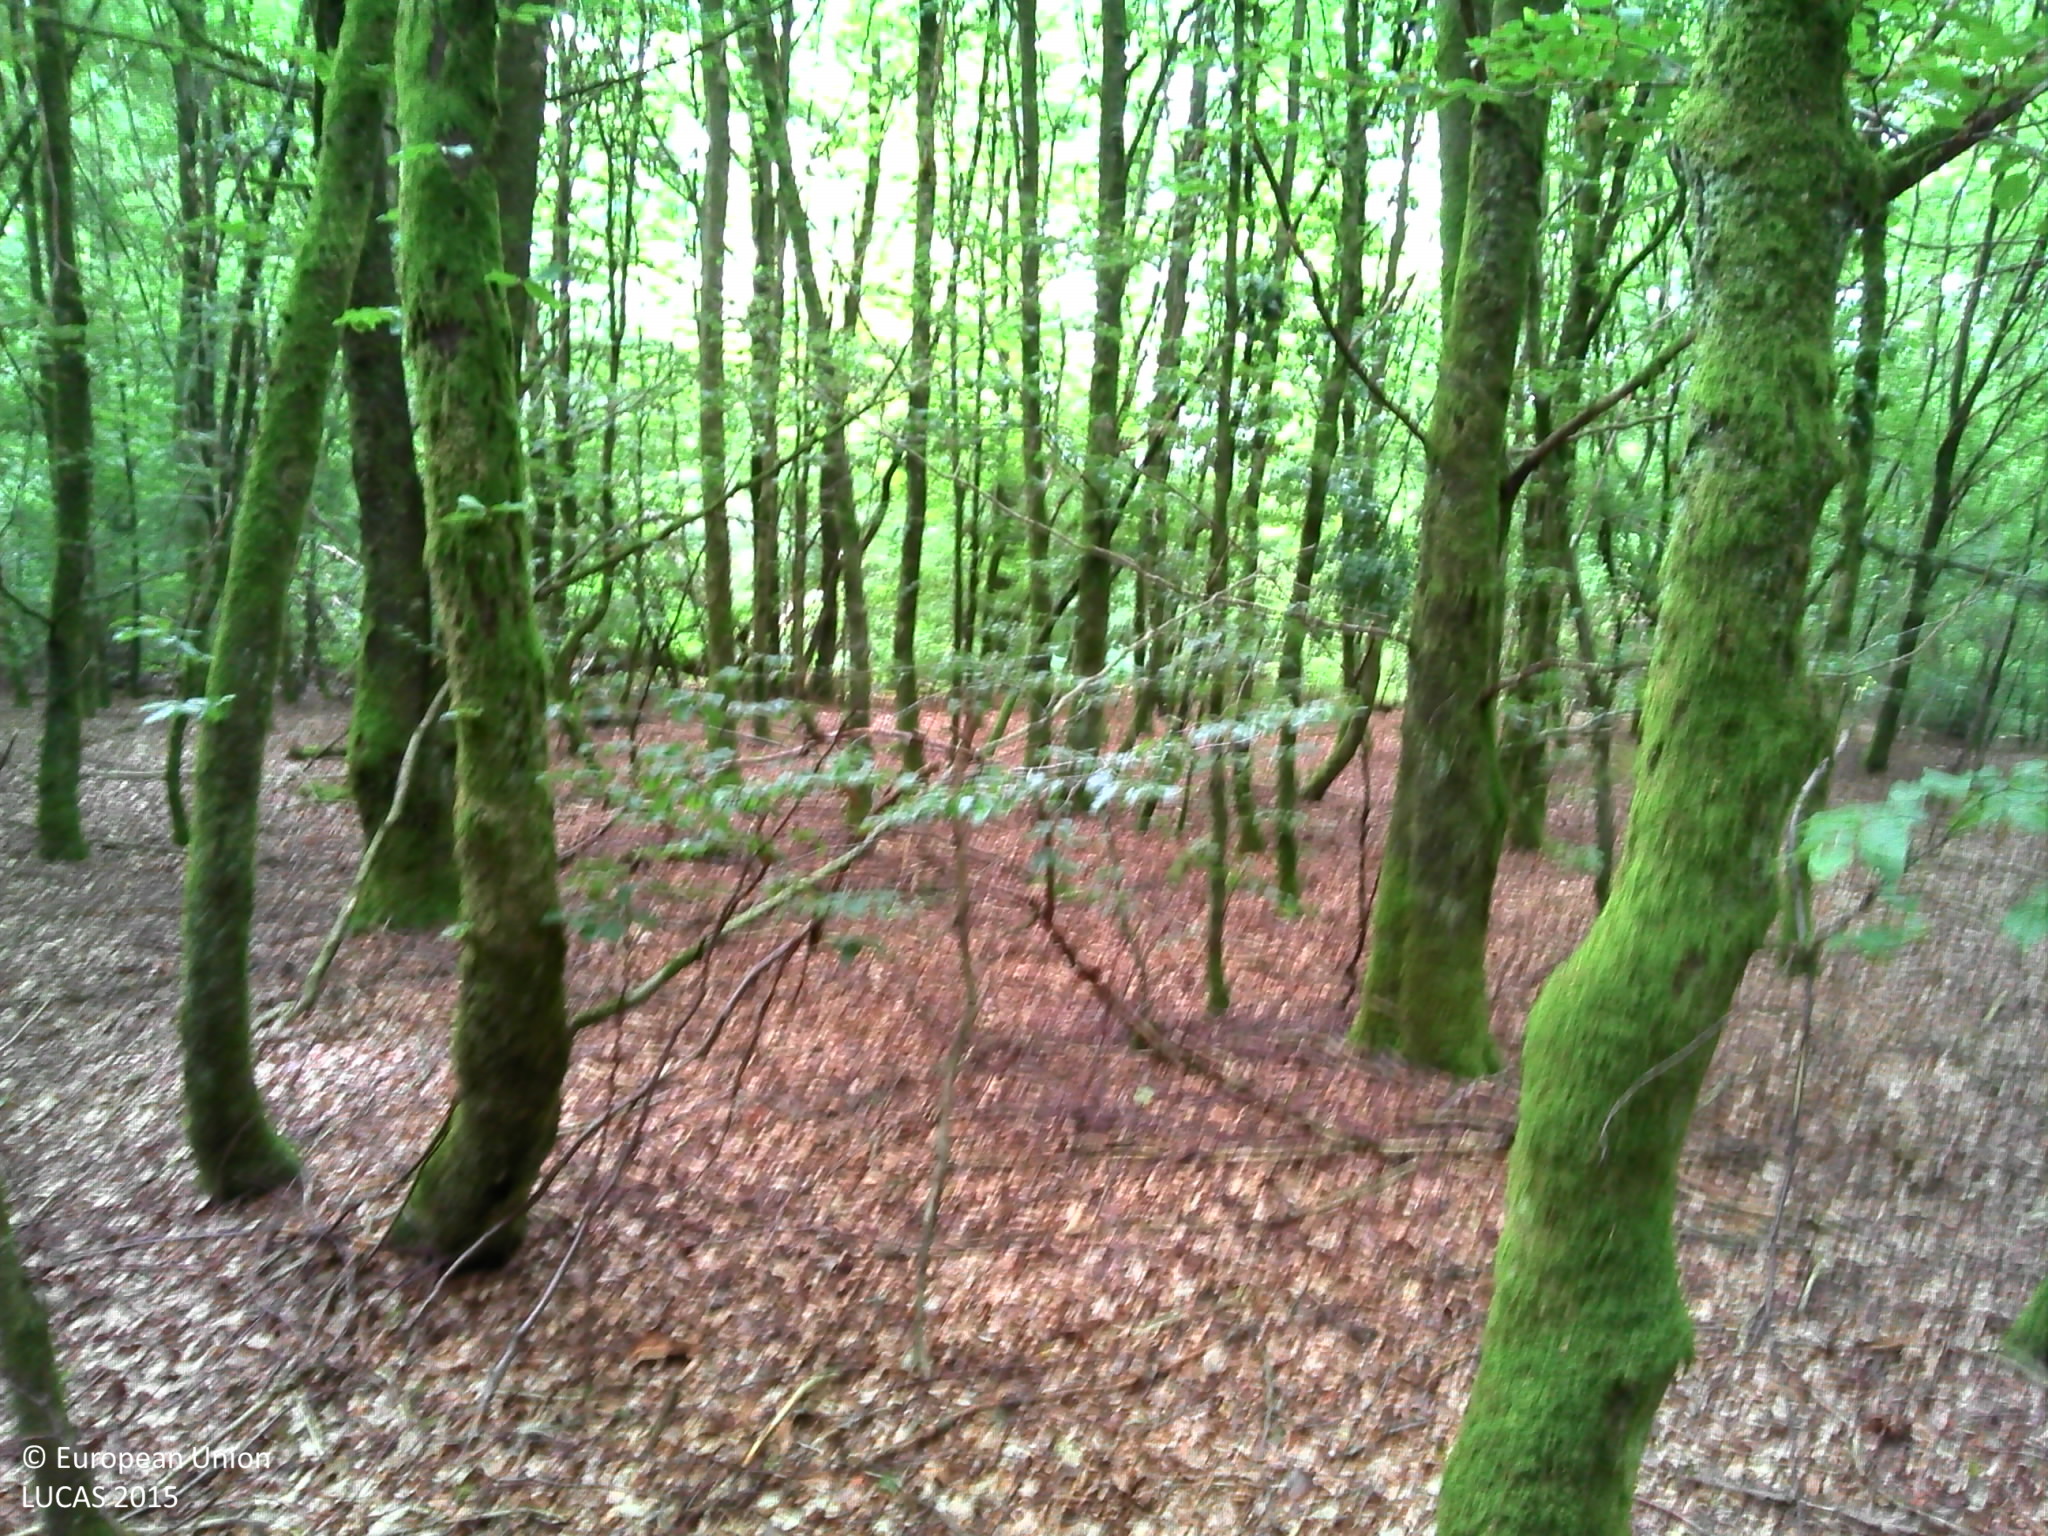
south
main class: Woodland
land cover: Broadleaved woodland
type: beech forest
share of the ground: > 75 %
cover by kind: broadleaved forest trees 100 %
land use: Forestry
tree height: > 5 m
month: July
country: BE
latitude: 49.7381
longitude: 5.5722
